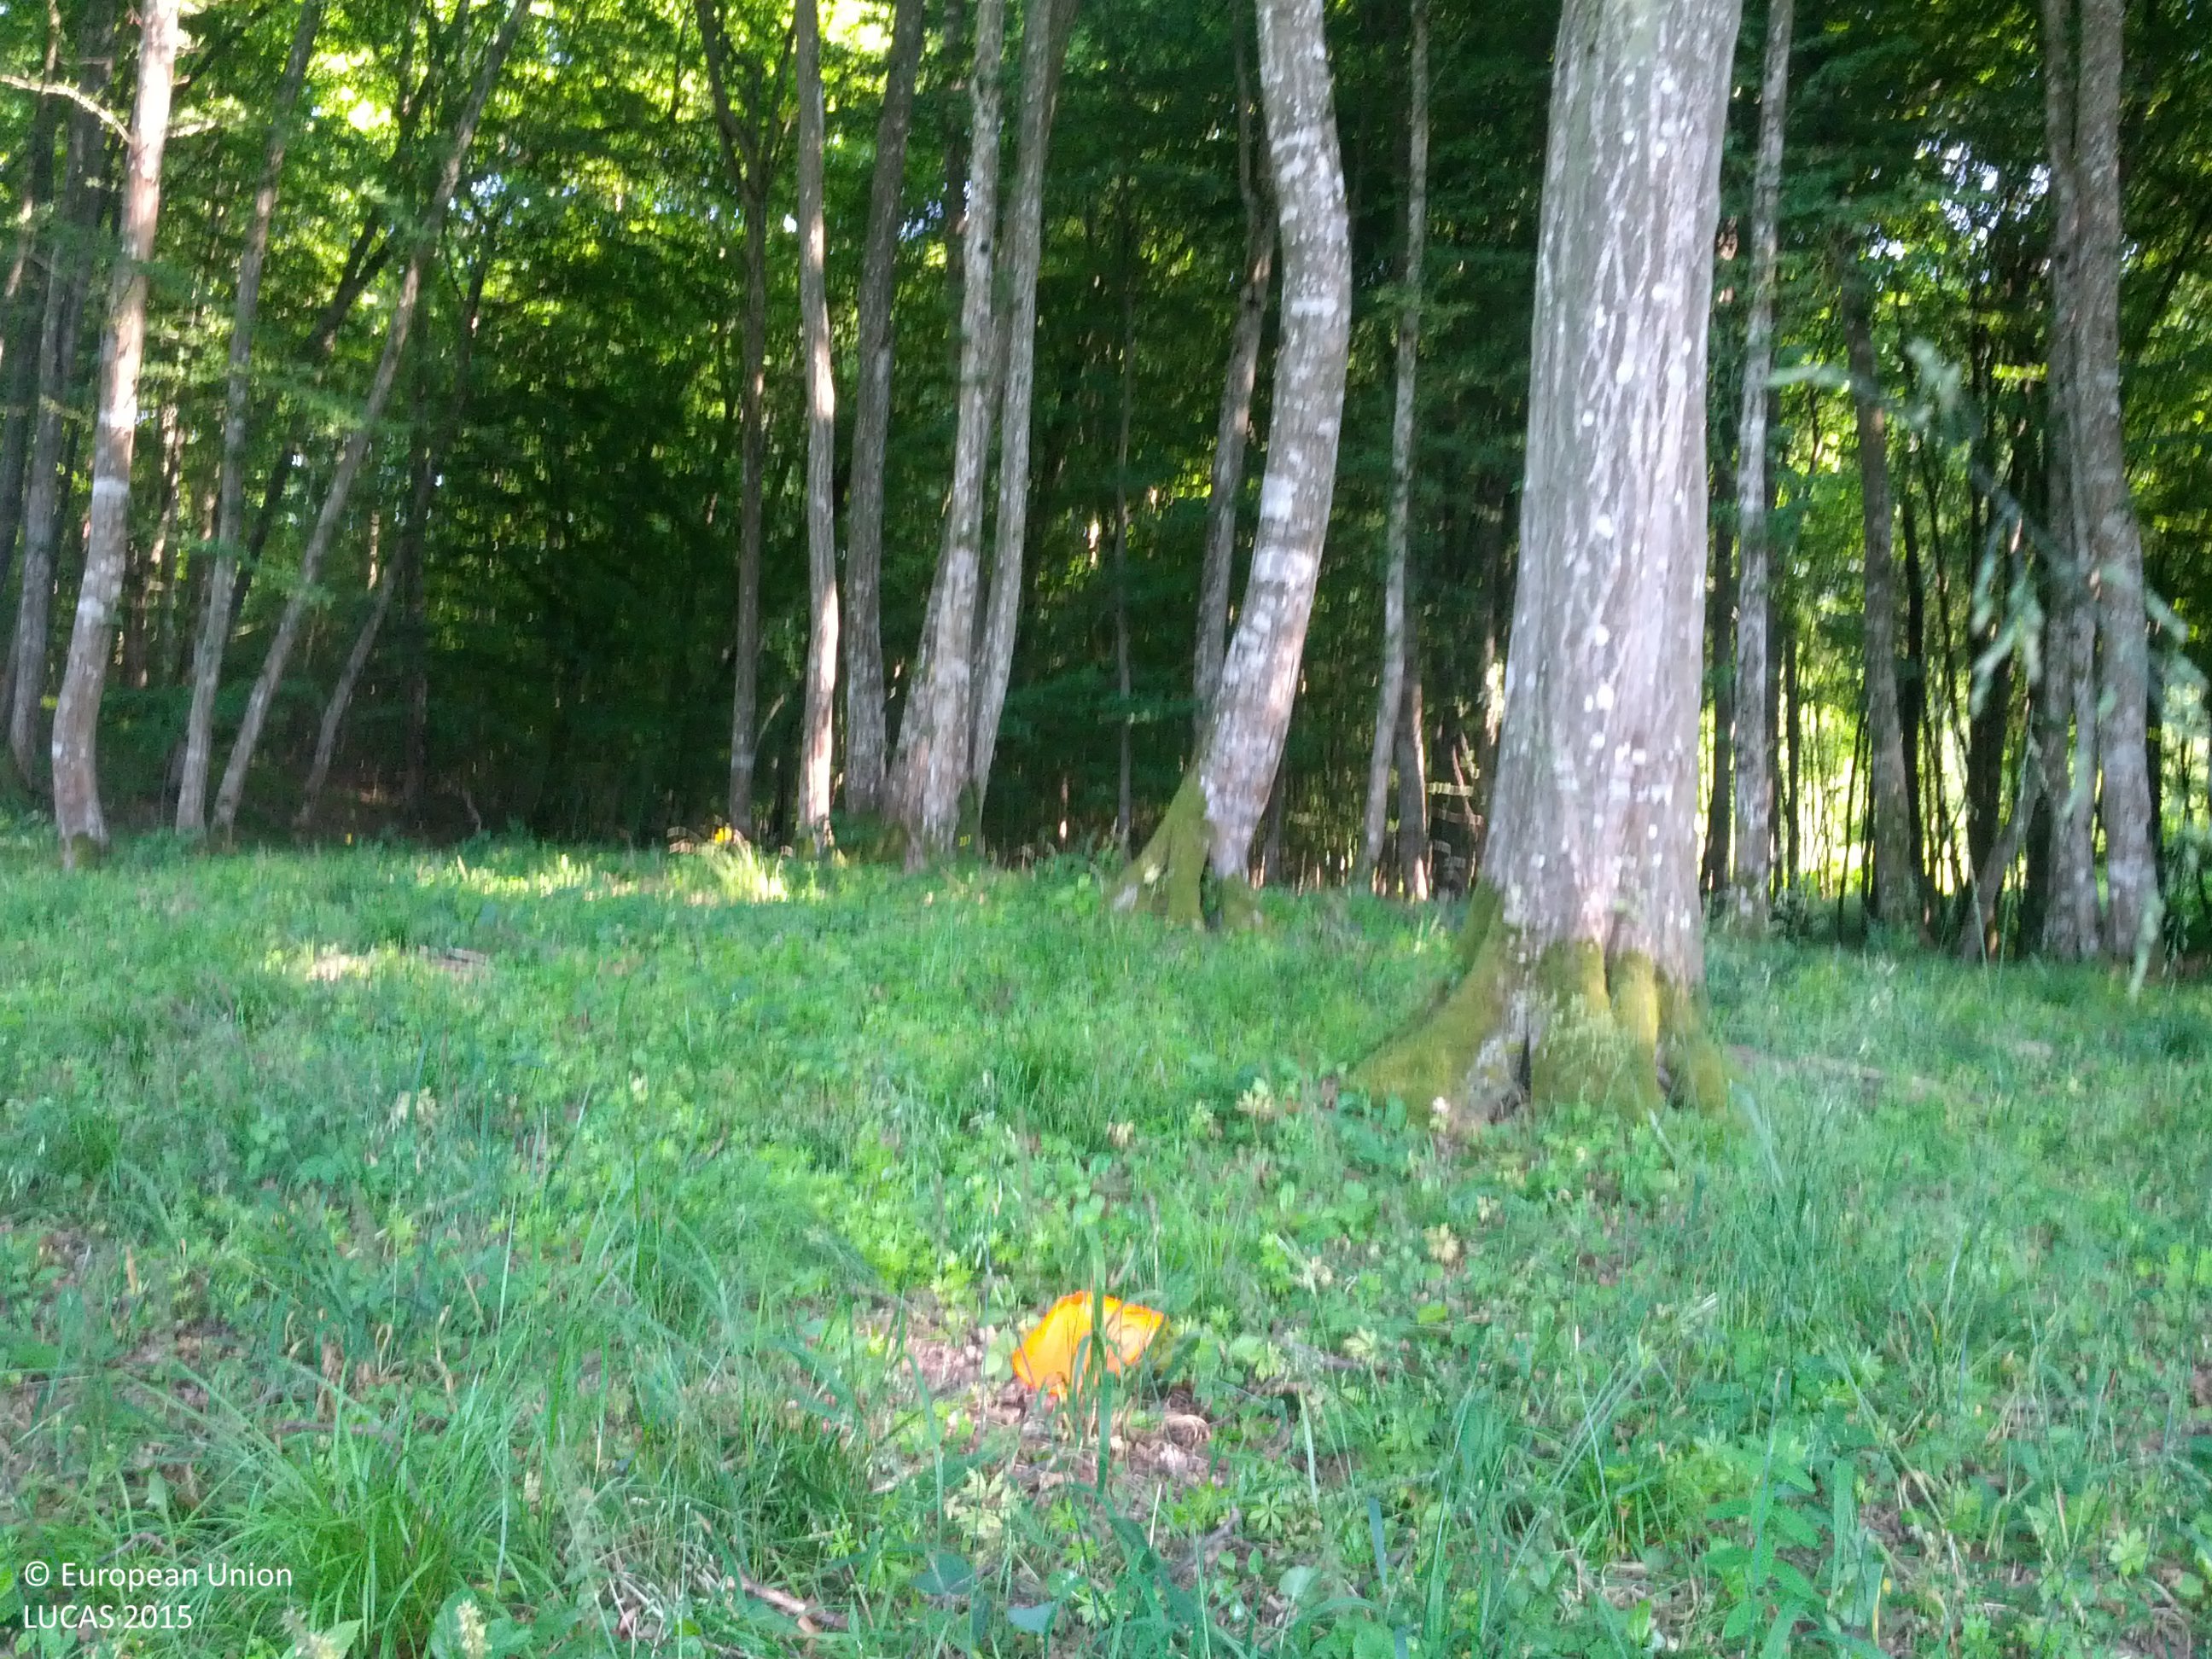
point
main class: Woodland
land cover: Broadleaved woodland
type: mountainous beech forest
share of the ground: > 75 %
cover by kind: broadleaved forest trees 80 %, herbaceous plants 15 %, coniferous forest trees 5 %
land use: Forestry
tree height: > 5 m
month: June
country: AT
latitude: 47.0275
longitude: 16.3838
